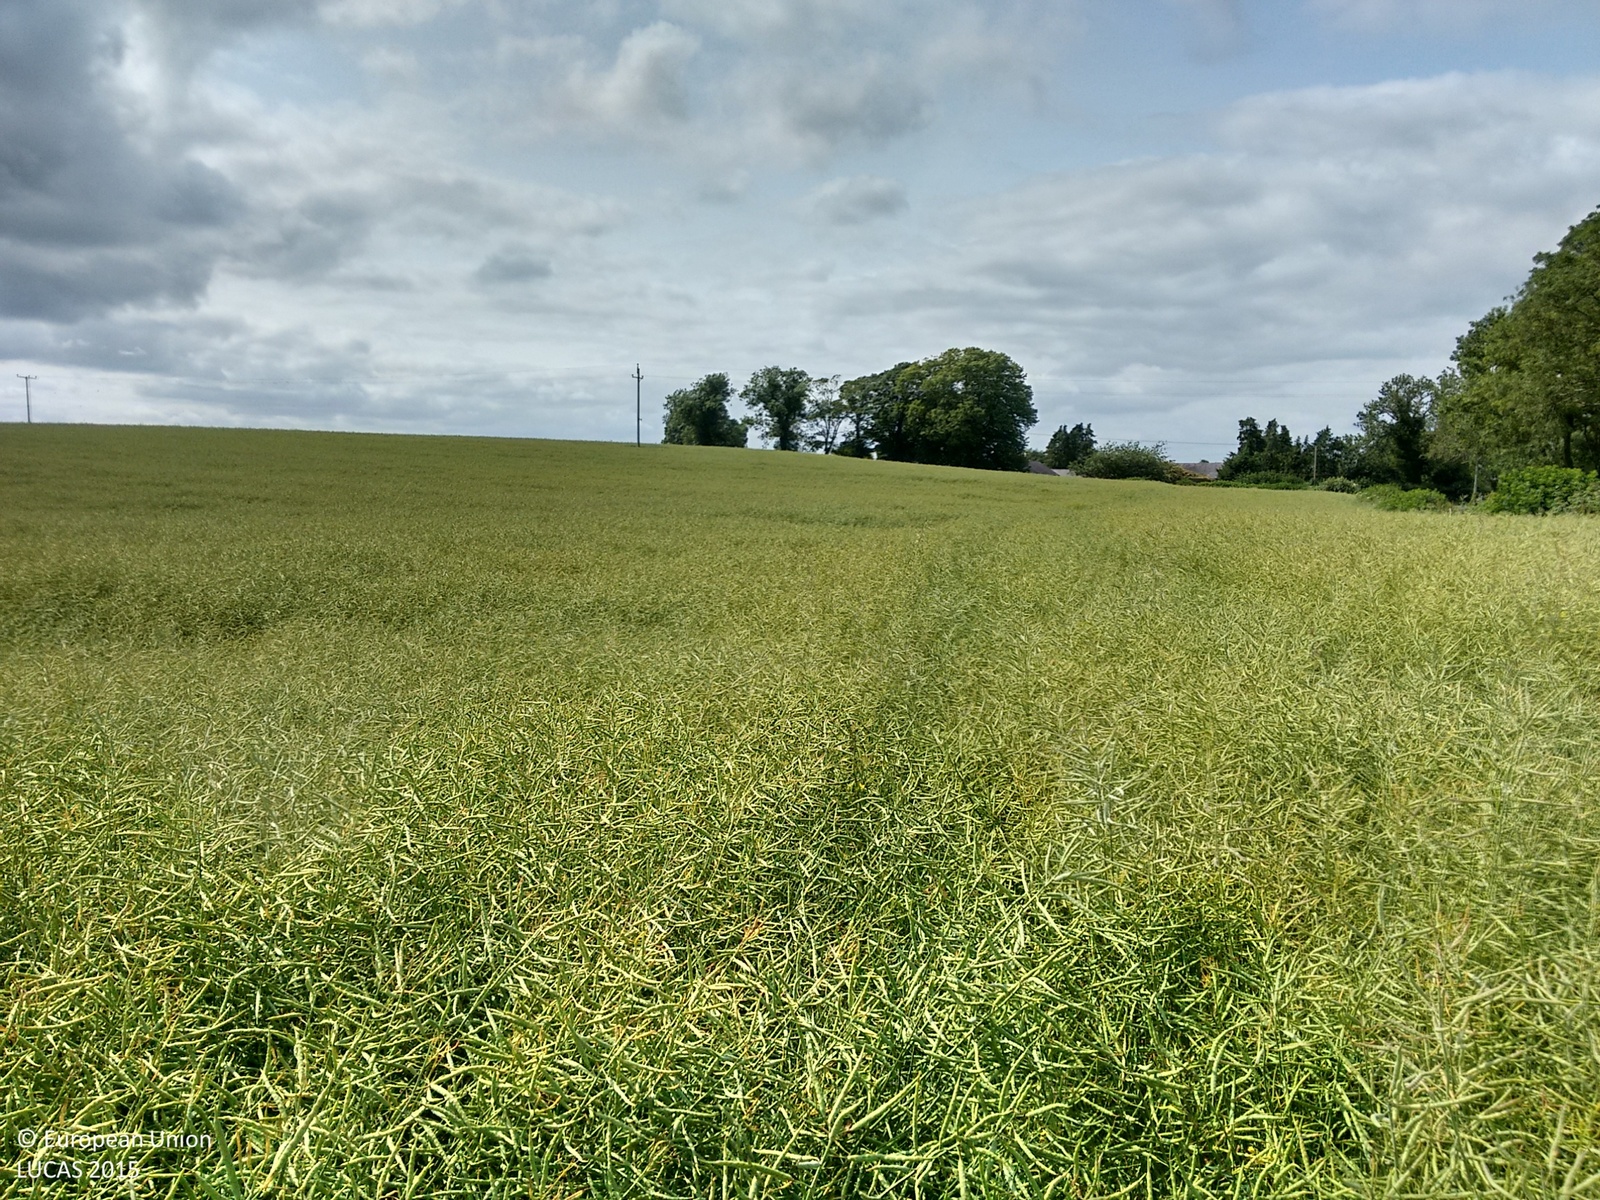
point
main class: Cropland
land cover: Rape and turnip rape
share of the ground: > 75 %
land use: Agriculture (excluding fallow land and kitchen gardens)
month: July
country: IE
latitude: 53.0745
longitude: -6.8400
